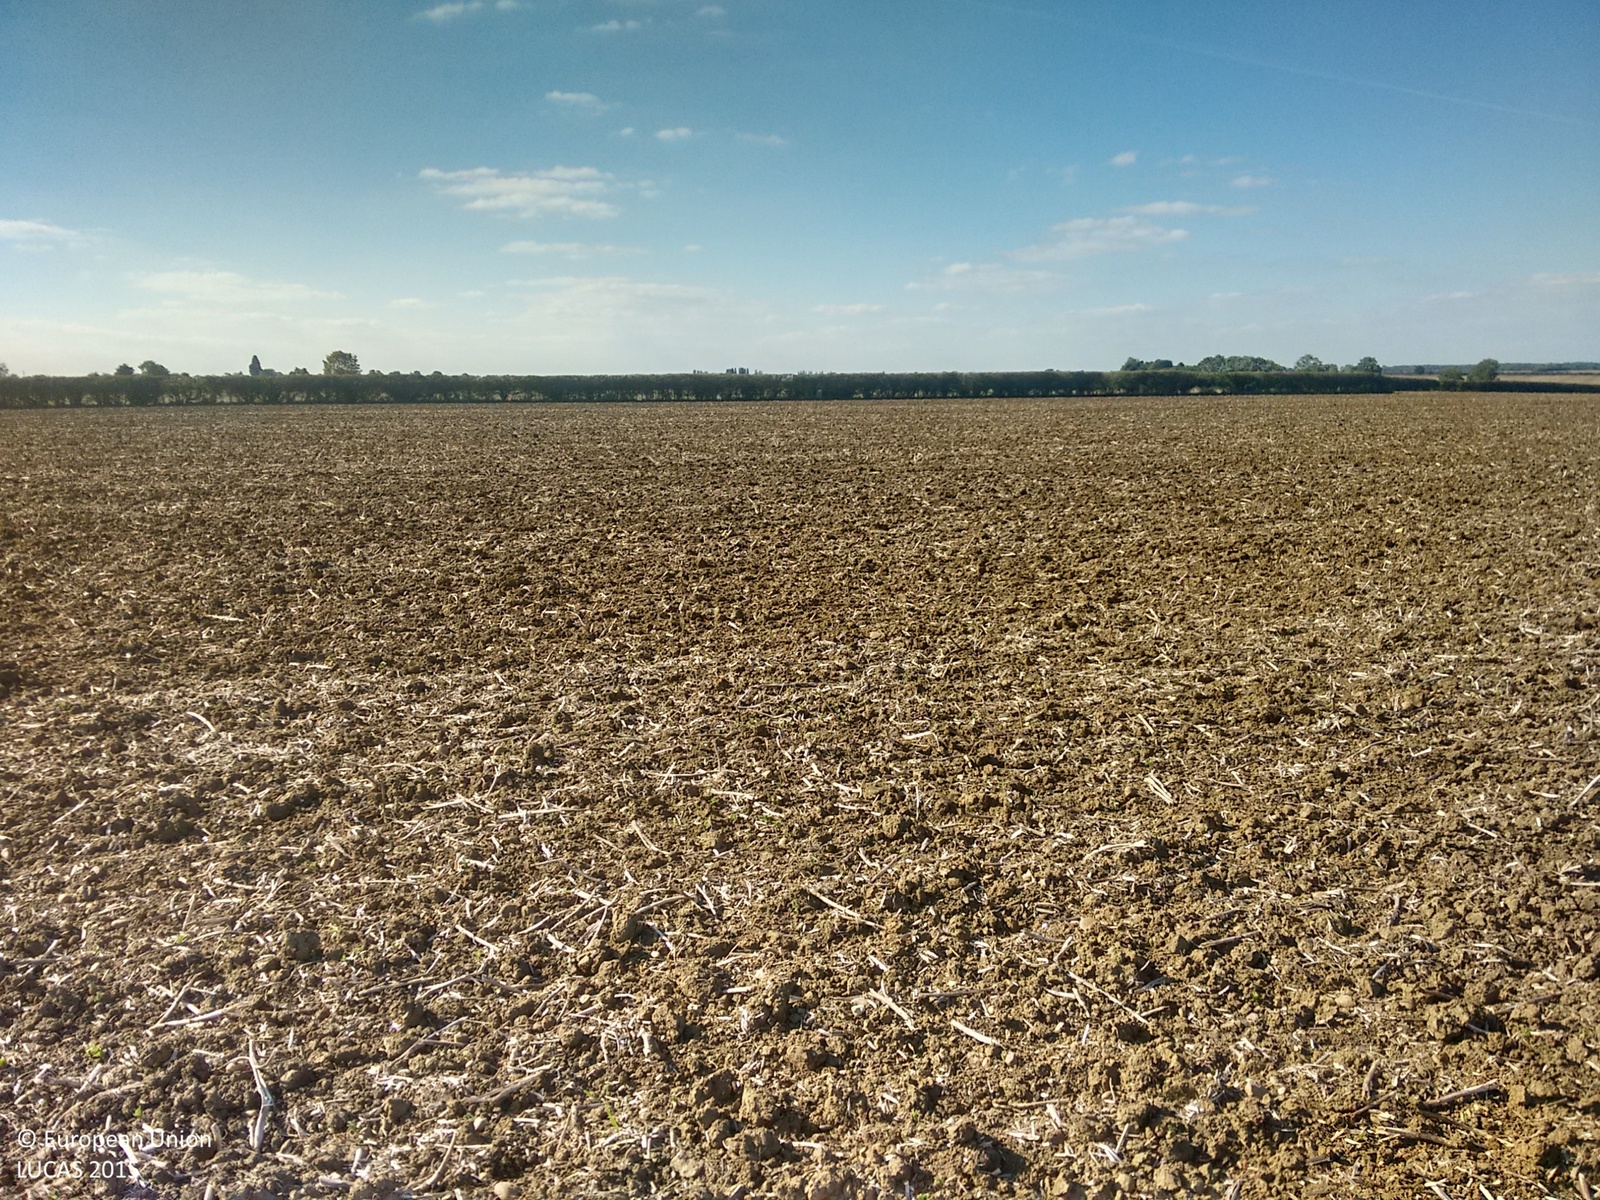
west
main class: Cropland
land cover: Rape and turnip rape
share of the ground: 10 - 25 %
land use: Agriculture (excluding fallow land and kitchen gardens)
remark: Harvested field
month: September
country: GB
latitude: 52.3937
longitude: -0.3674
